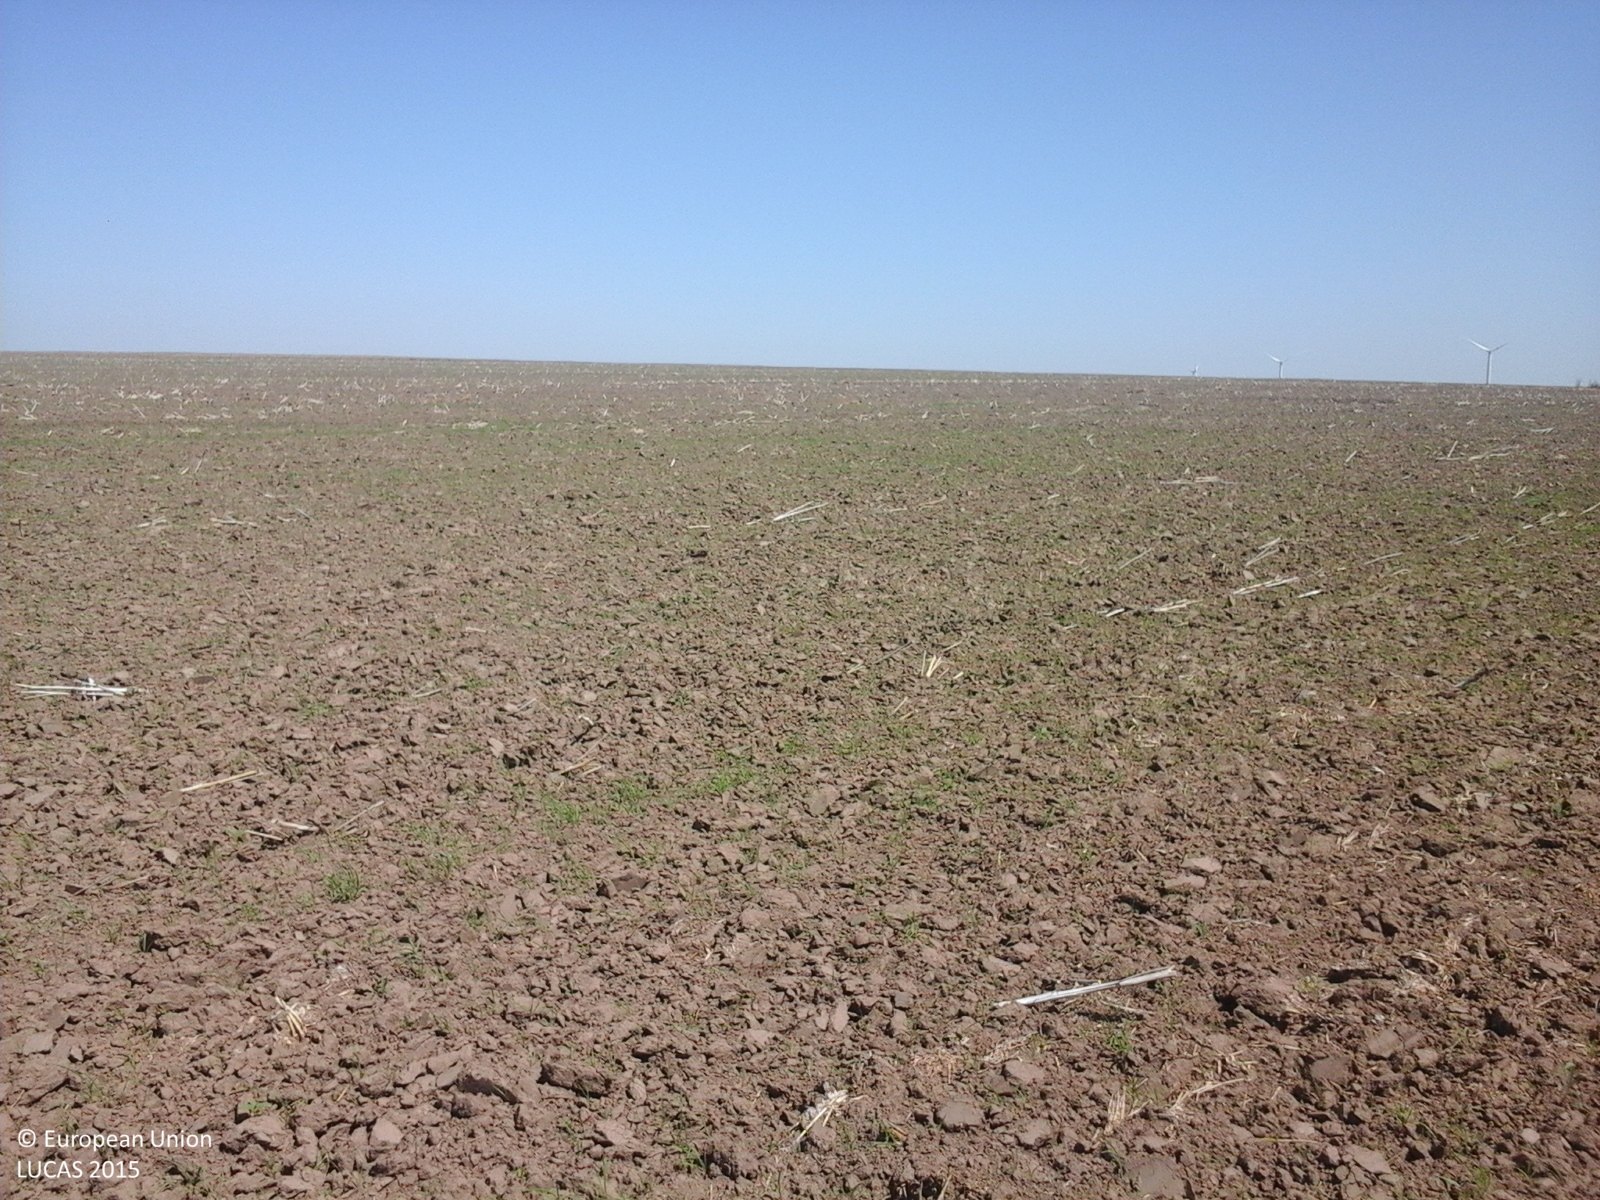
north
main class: Cropland
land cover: Rape and turnip rape
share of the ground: < 10 %
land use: Agriculture (excluding fallow land and kitchen gardens)
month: August
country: RO
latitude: 44.6595
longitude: 28.1091
